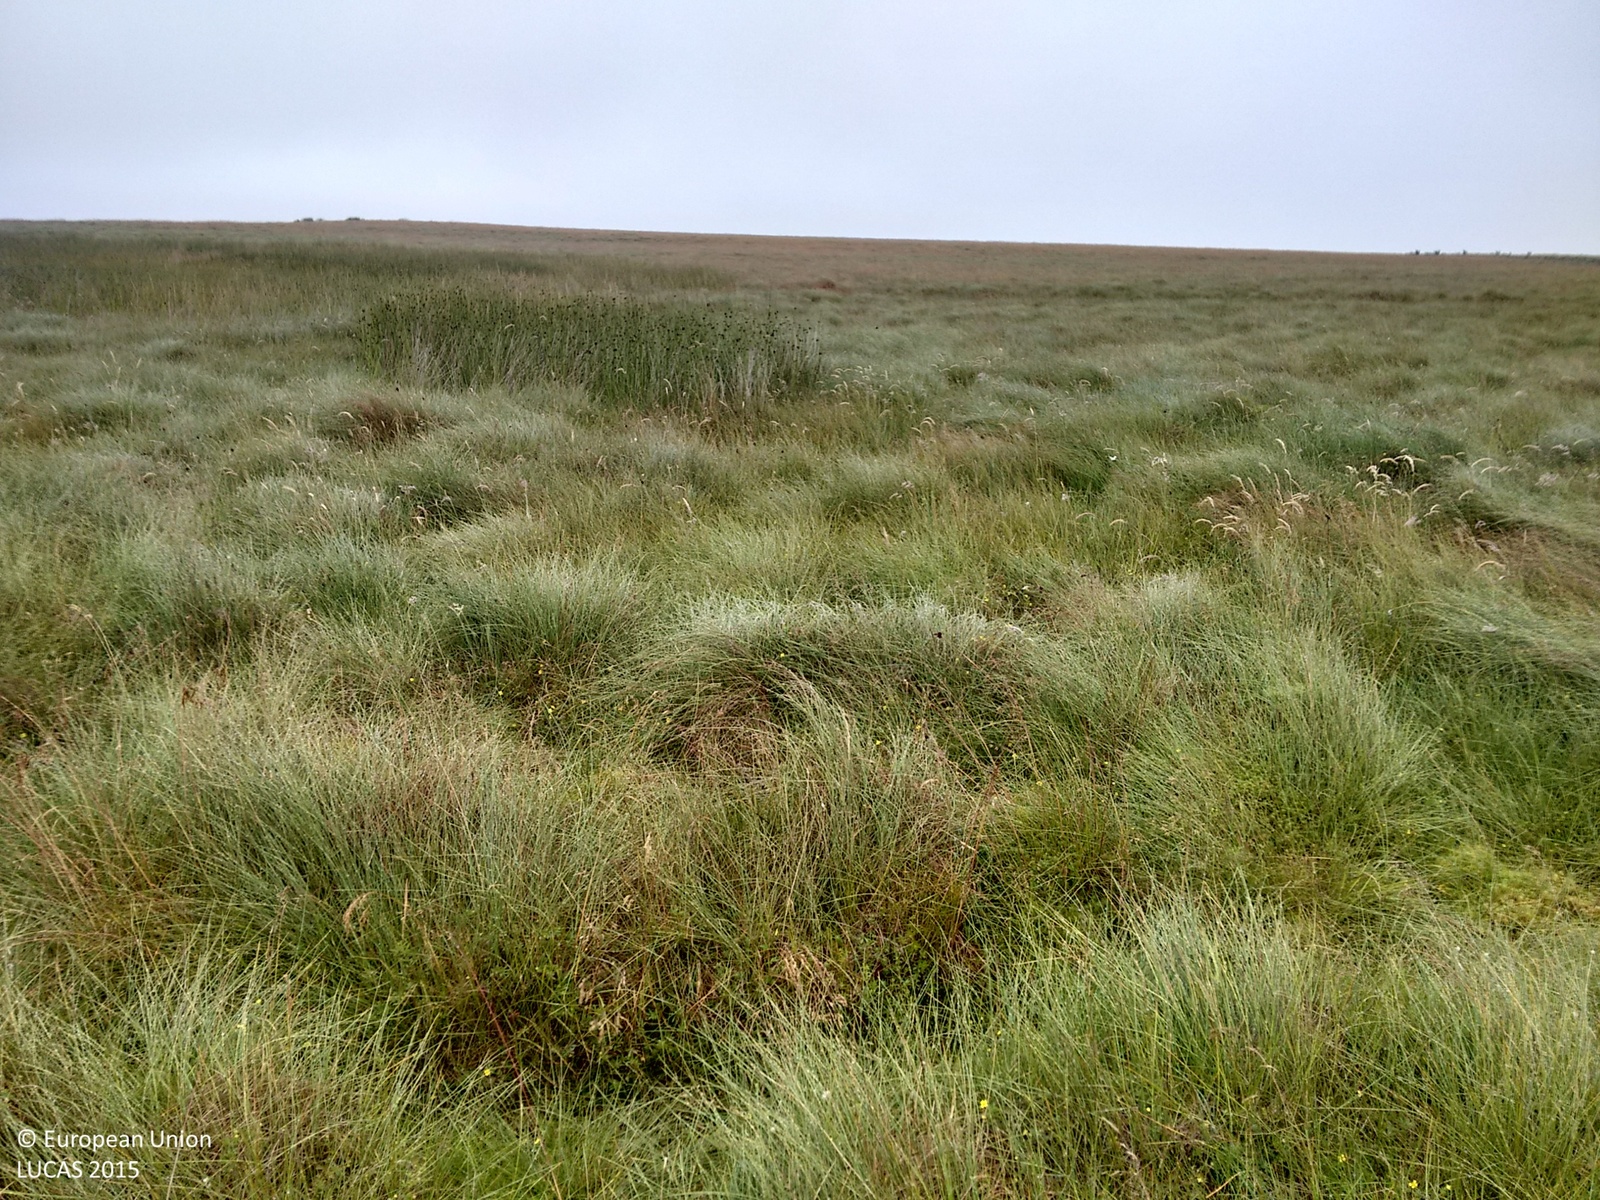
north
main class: Grassland
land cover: Grassland without tree/shrub cover
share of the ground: > 75 %
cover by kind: herbaceous plants 100 %
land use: Energy production
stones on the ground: < 10 %
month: August
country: GB
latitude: 58.4141
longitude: -3.2931
